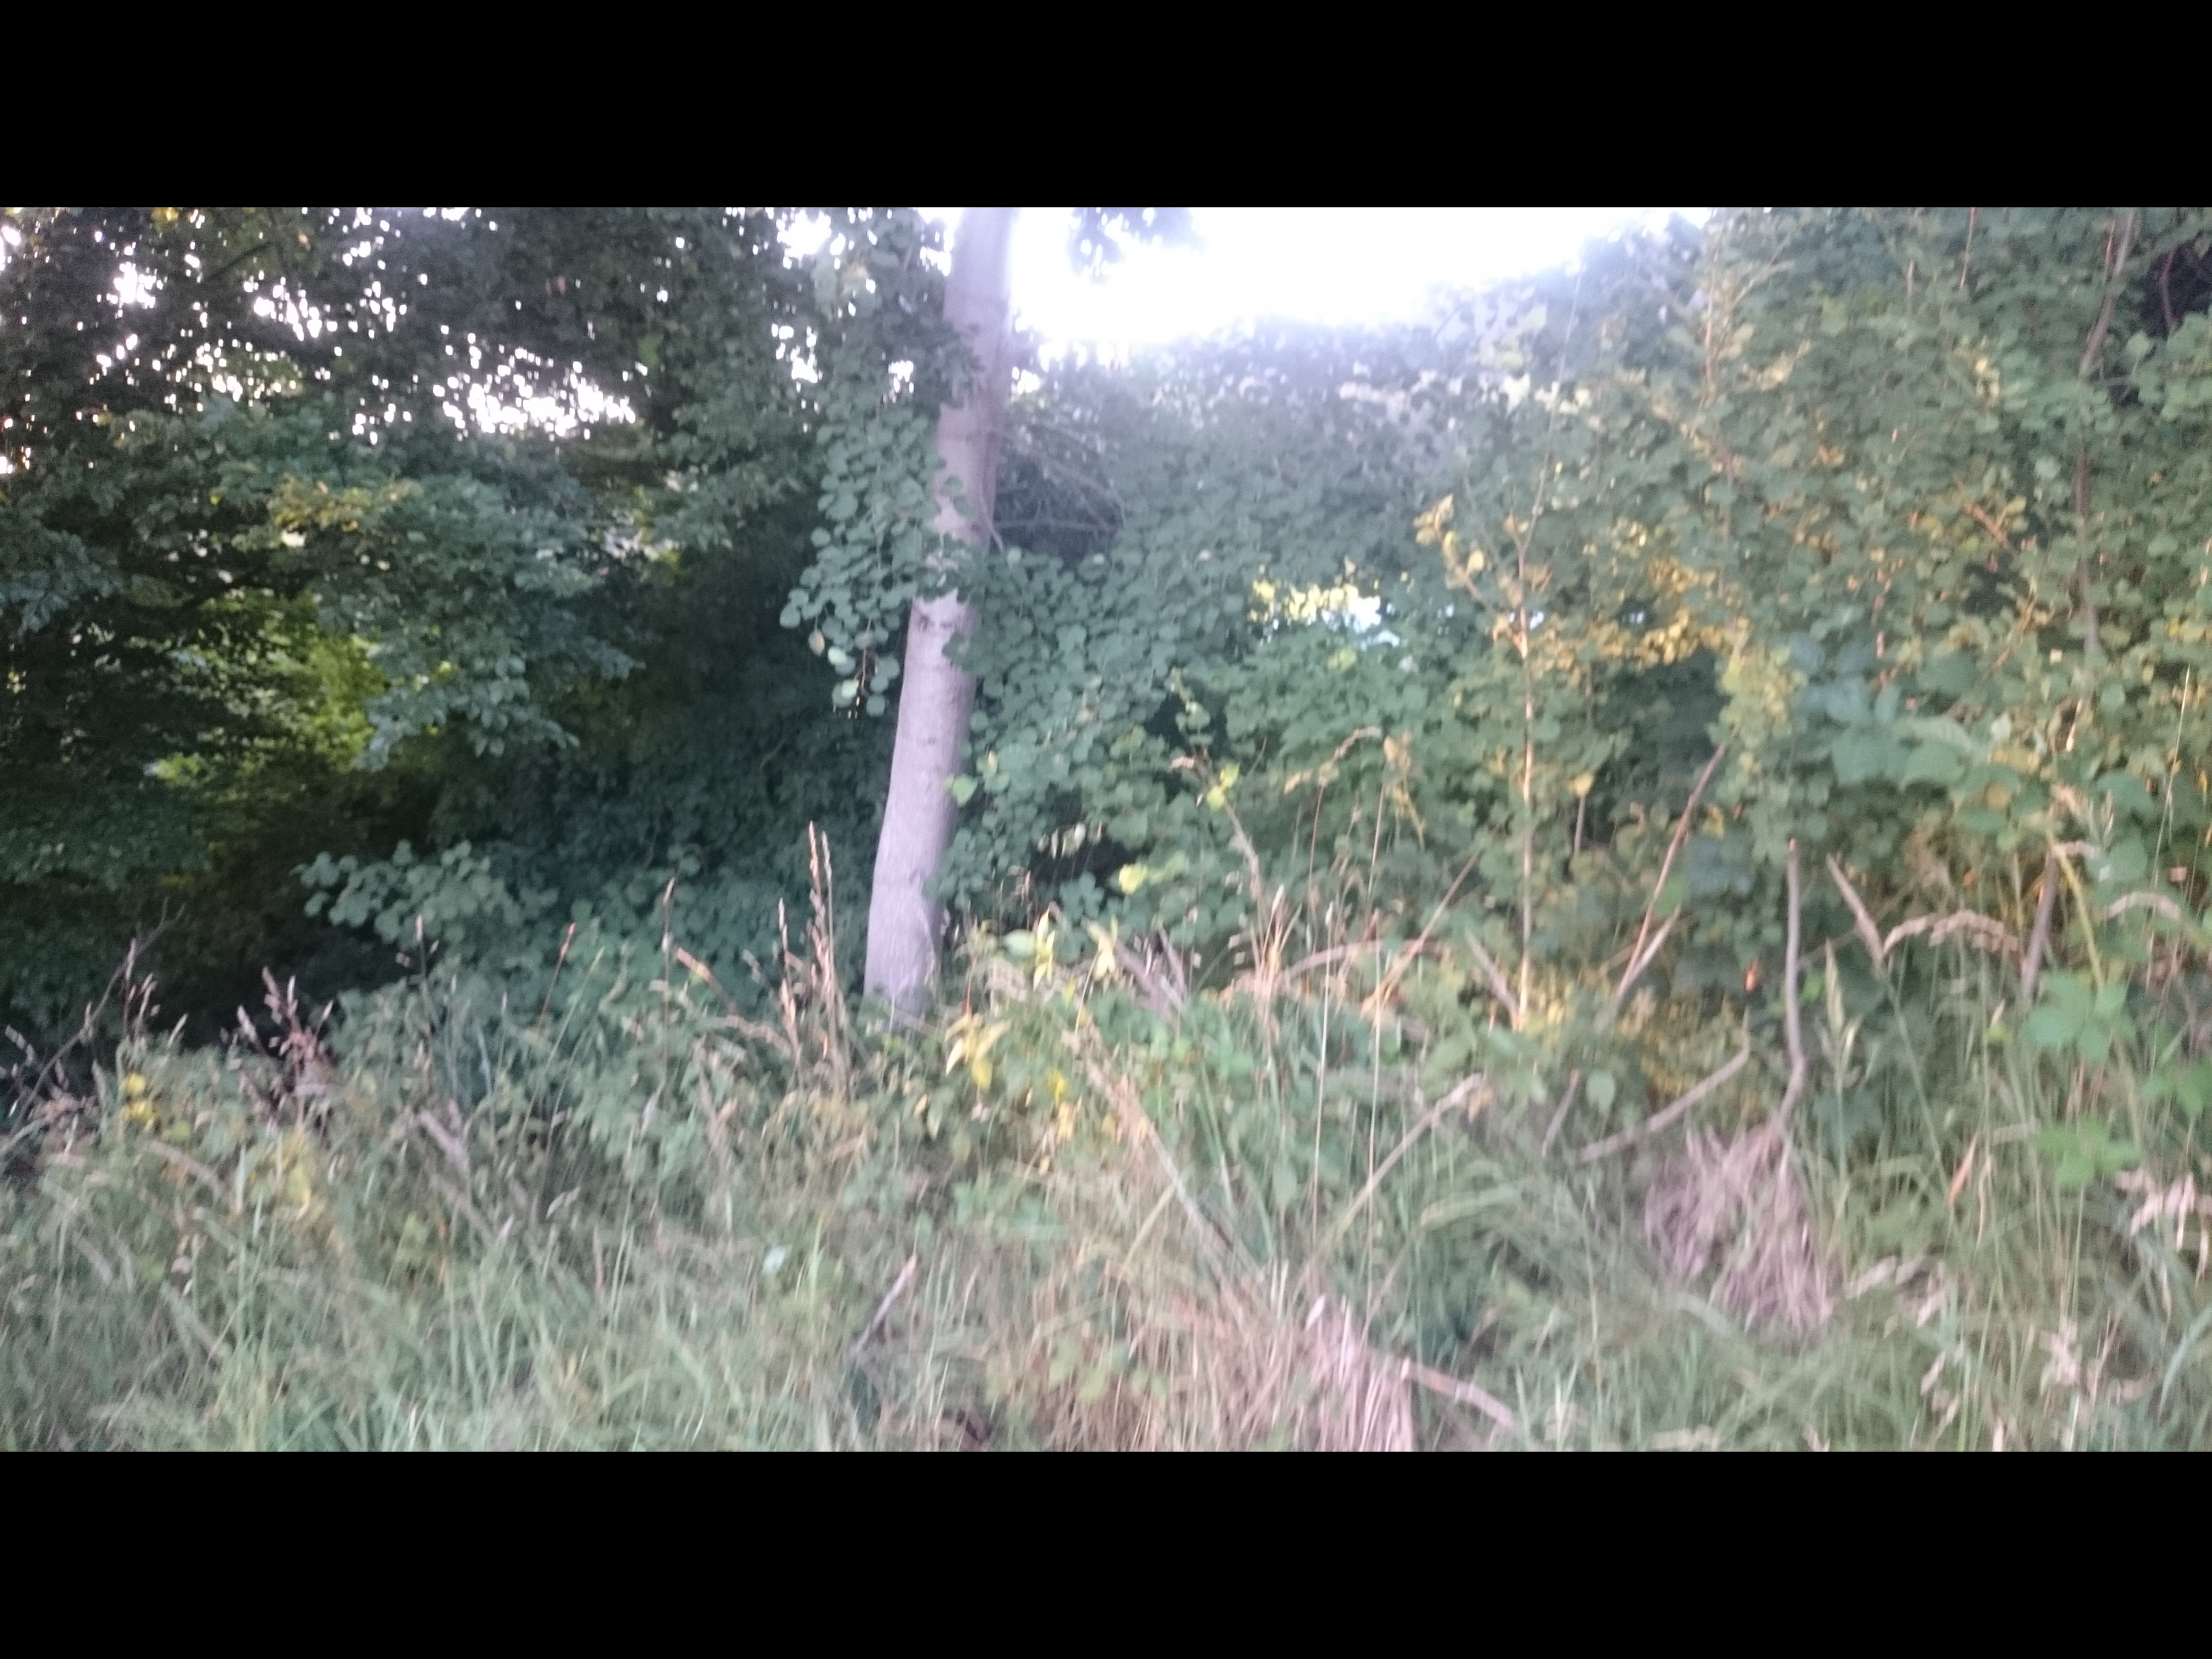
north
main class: Grassland
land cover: Grassland without tree/shrub cover
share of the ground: > 75 %
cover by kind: herbaceous plants 100 %
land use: Agriculture (excluding fallow land and kitchen gardens)
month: July
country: AT
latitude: 47.3002
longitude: 15.7010
